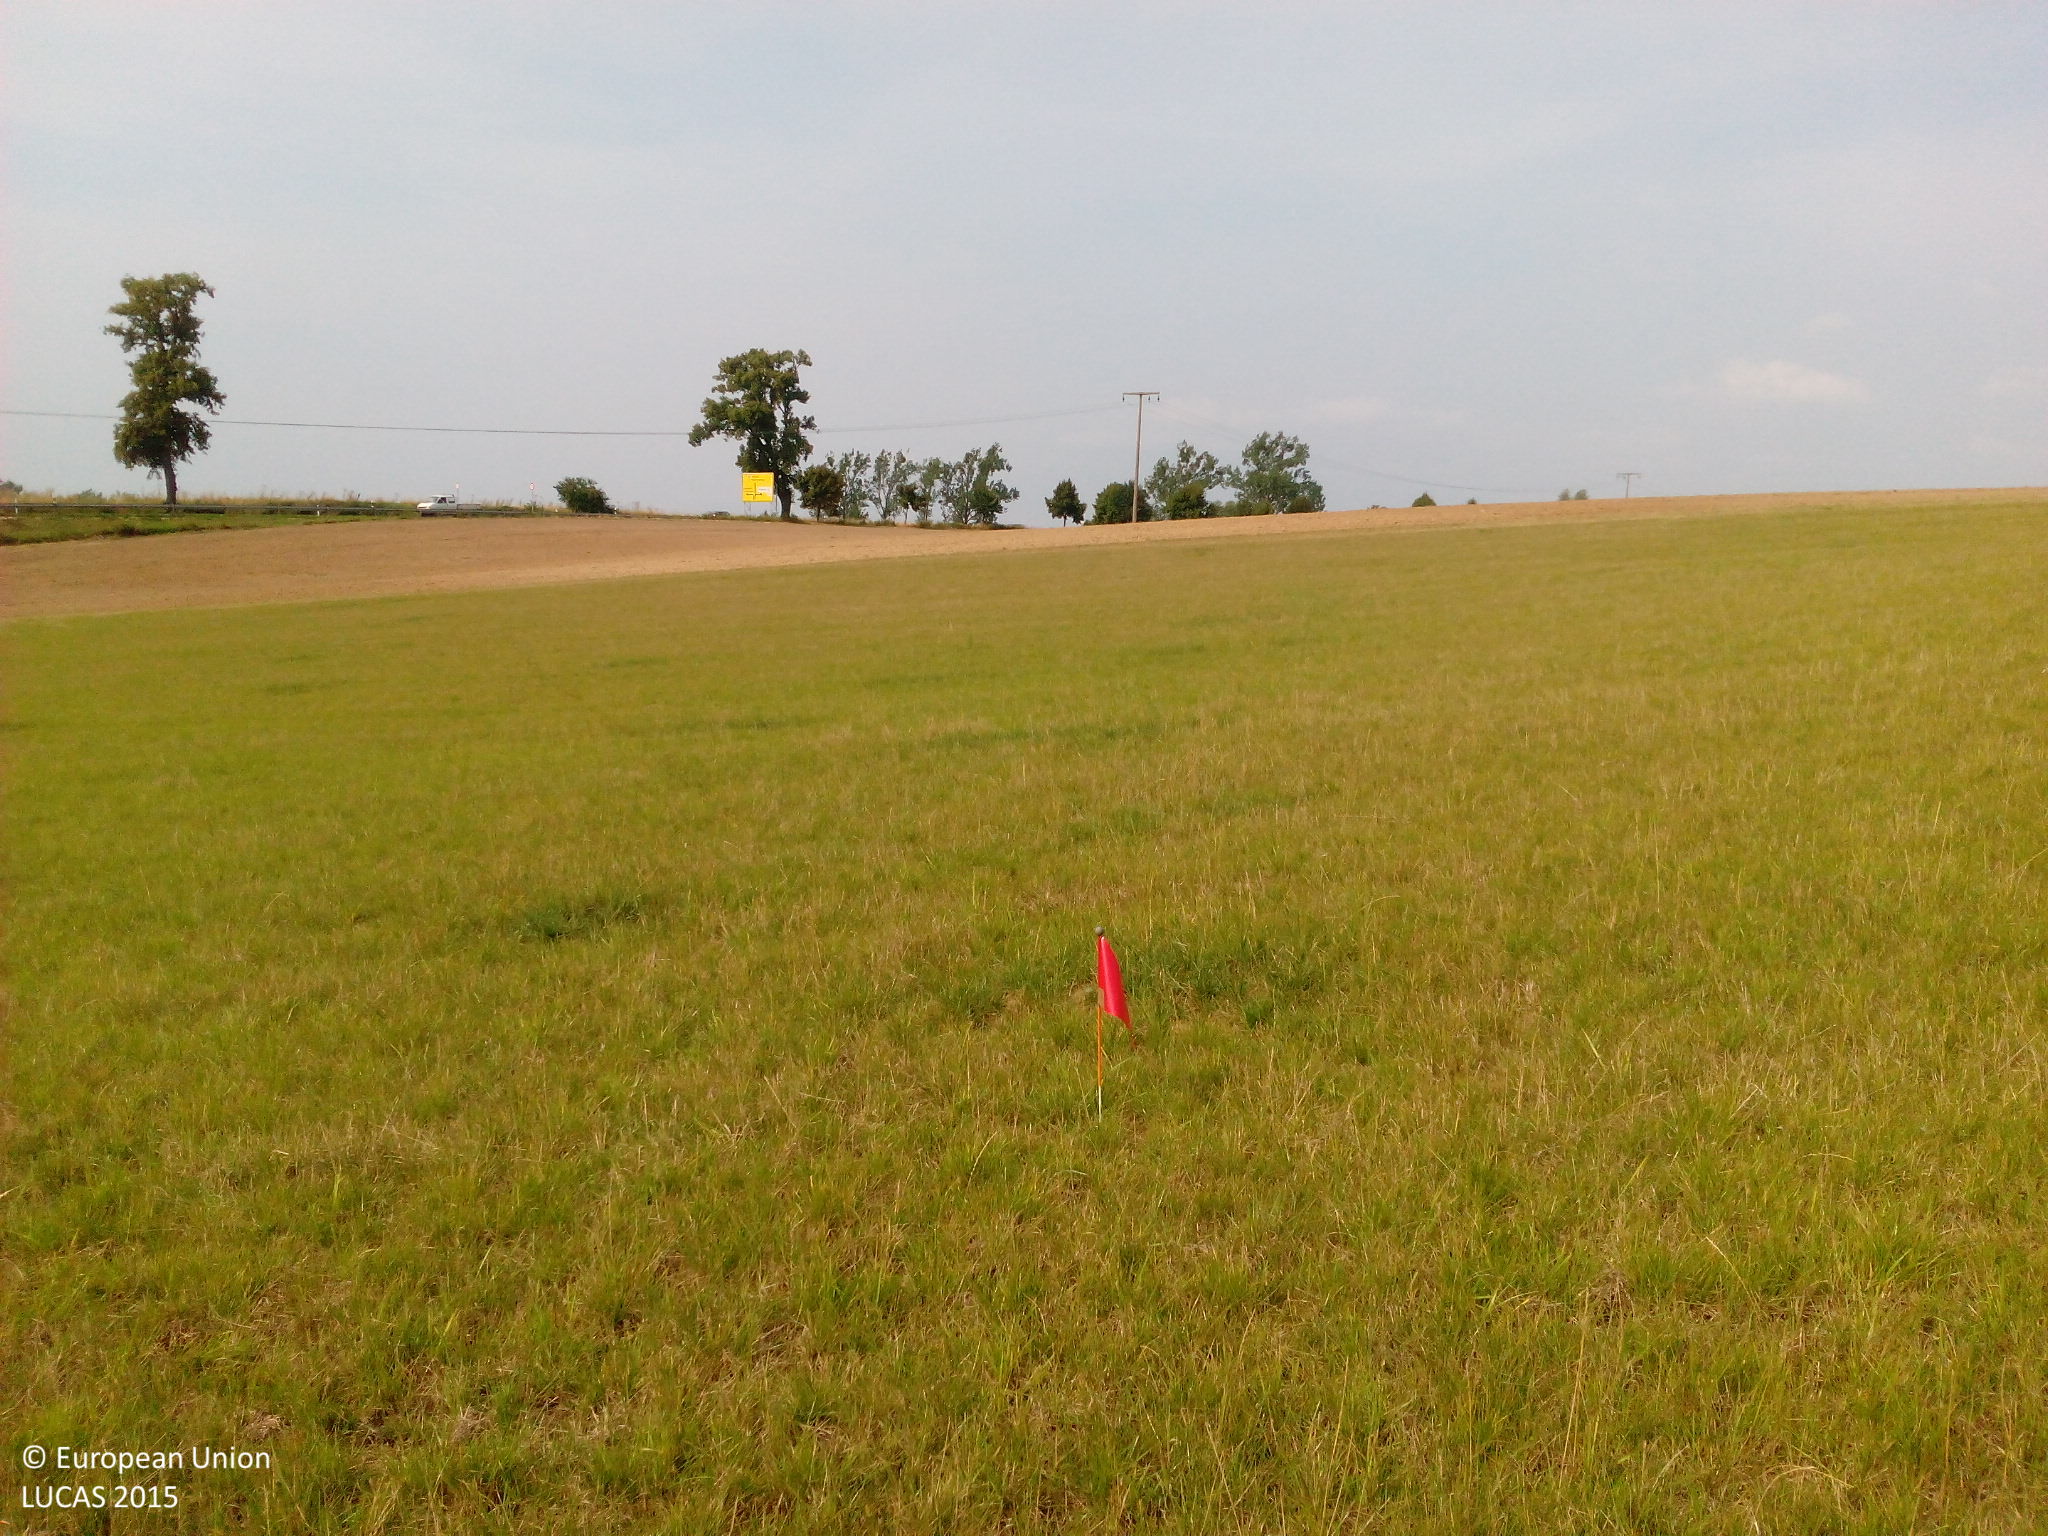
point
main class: Cropland
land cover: Temporary grasslands
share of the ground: > 75 %
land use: Agriculture (excluding fallow land and kitchen gardens)
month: August
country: DE
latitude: 53.4674
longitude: 13.2082
